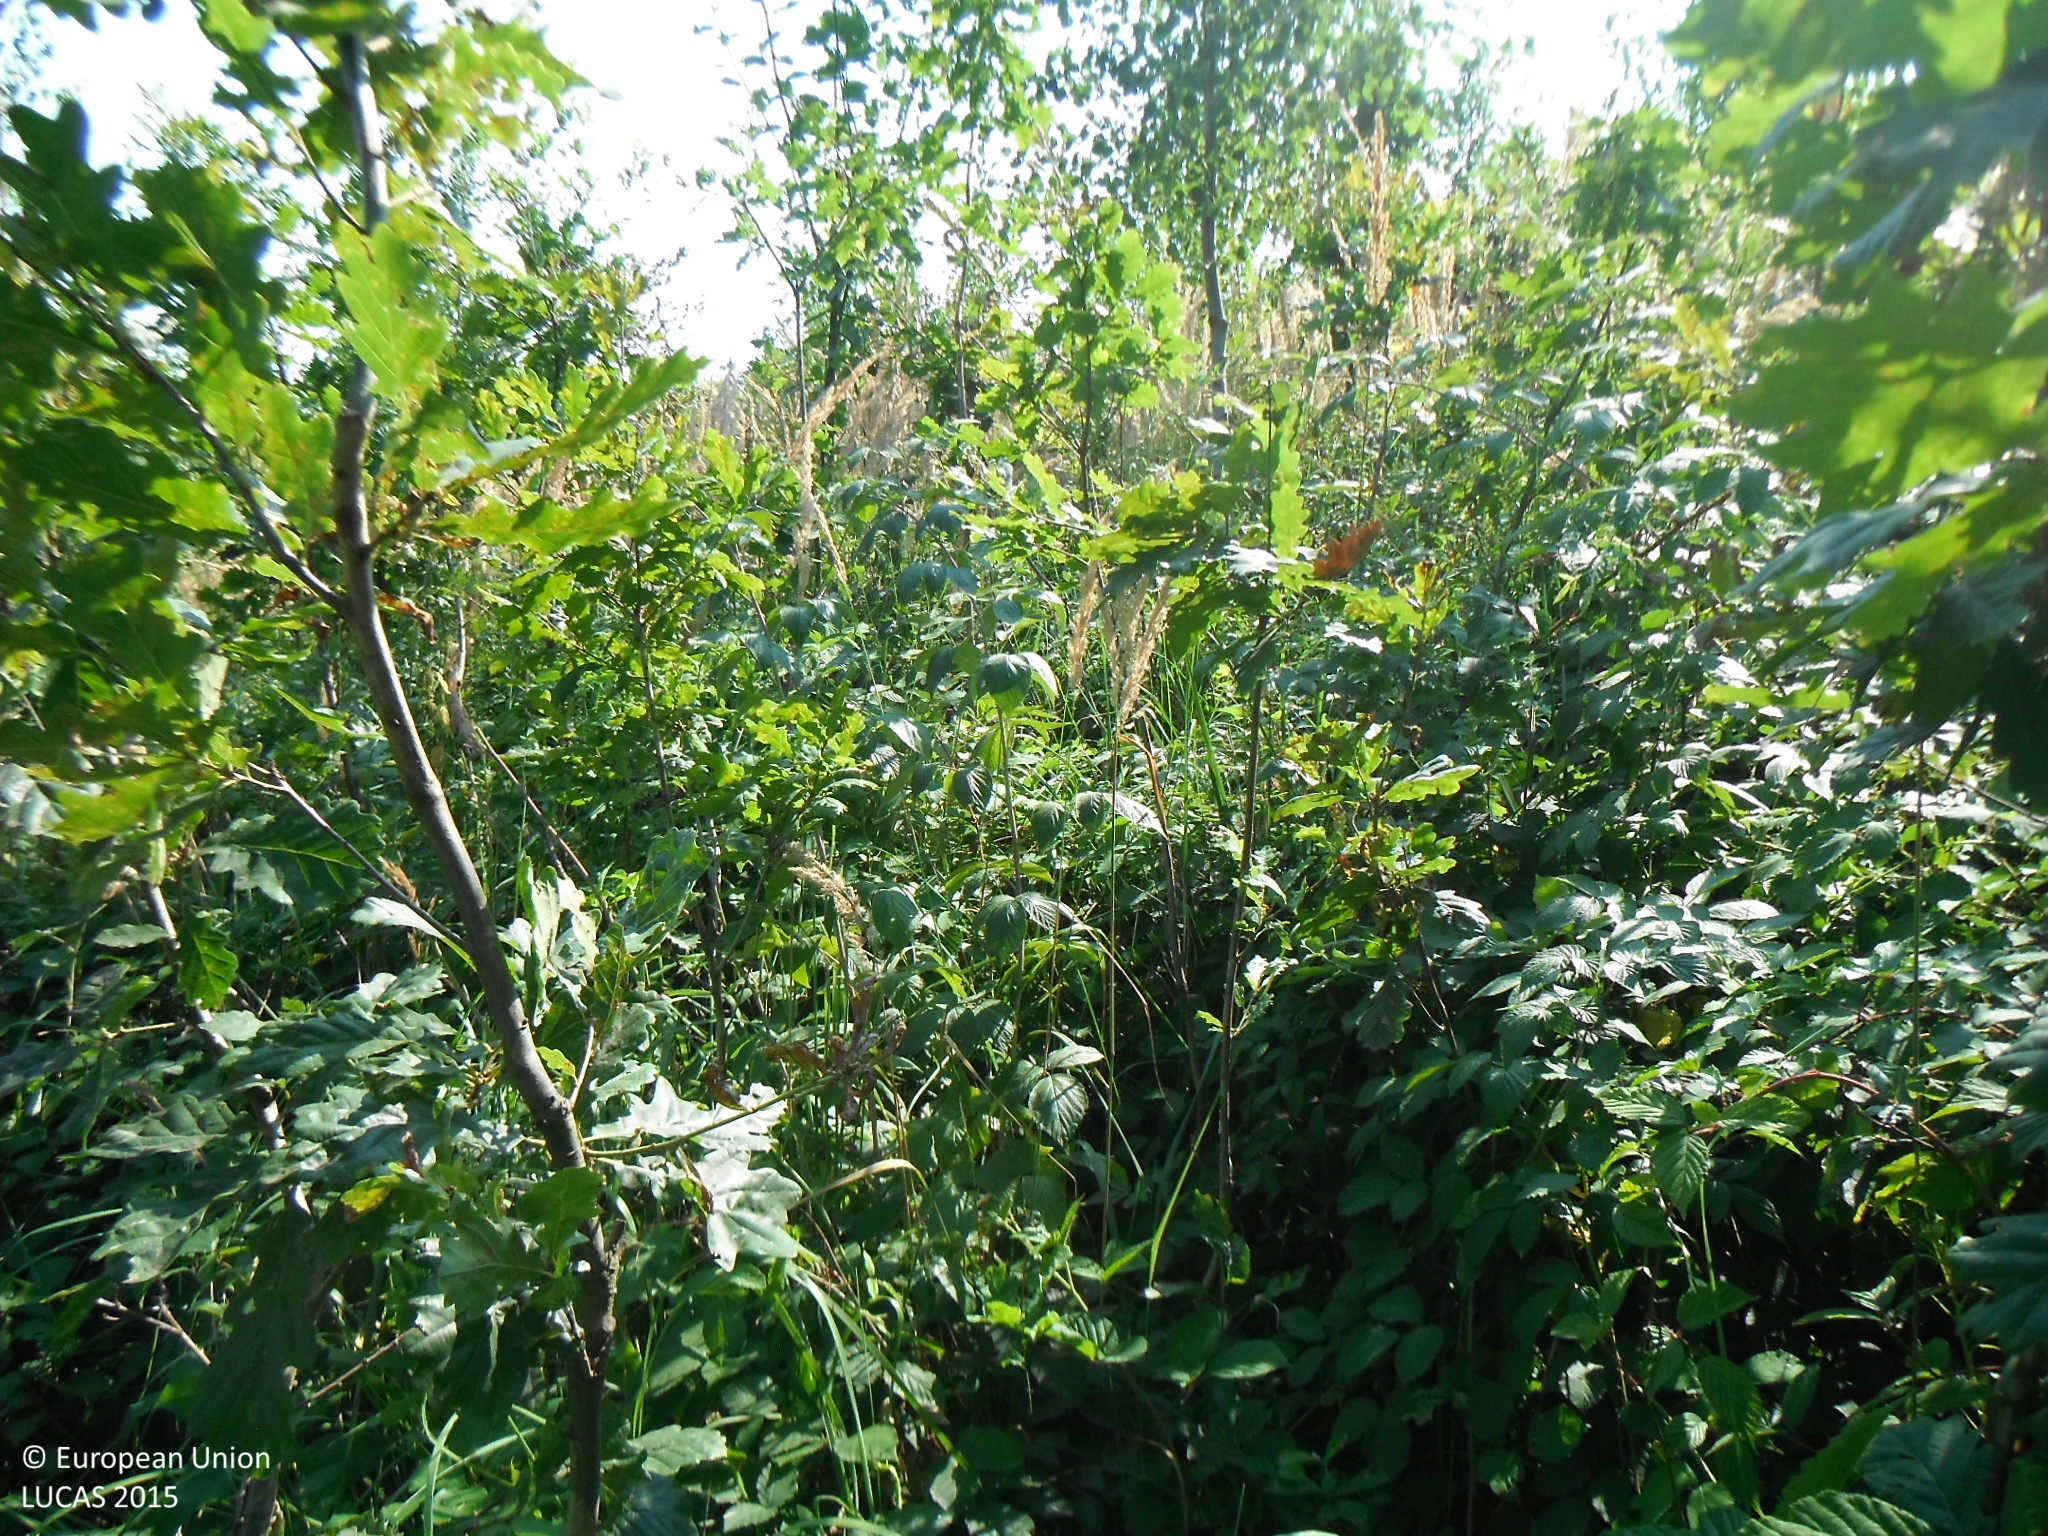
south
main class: Woodland
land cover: Broadleaved woodland
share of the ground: > 75 %
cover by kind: broadleaved forest trees 60 %, shrubs 35 %, herbaceous plants 5 %
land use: Forestry
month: August
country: SK
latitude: 49.0699
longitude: 18.2702
